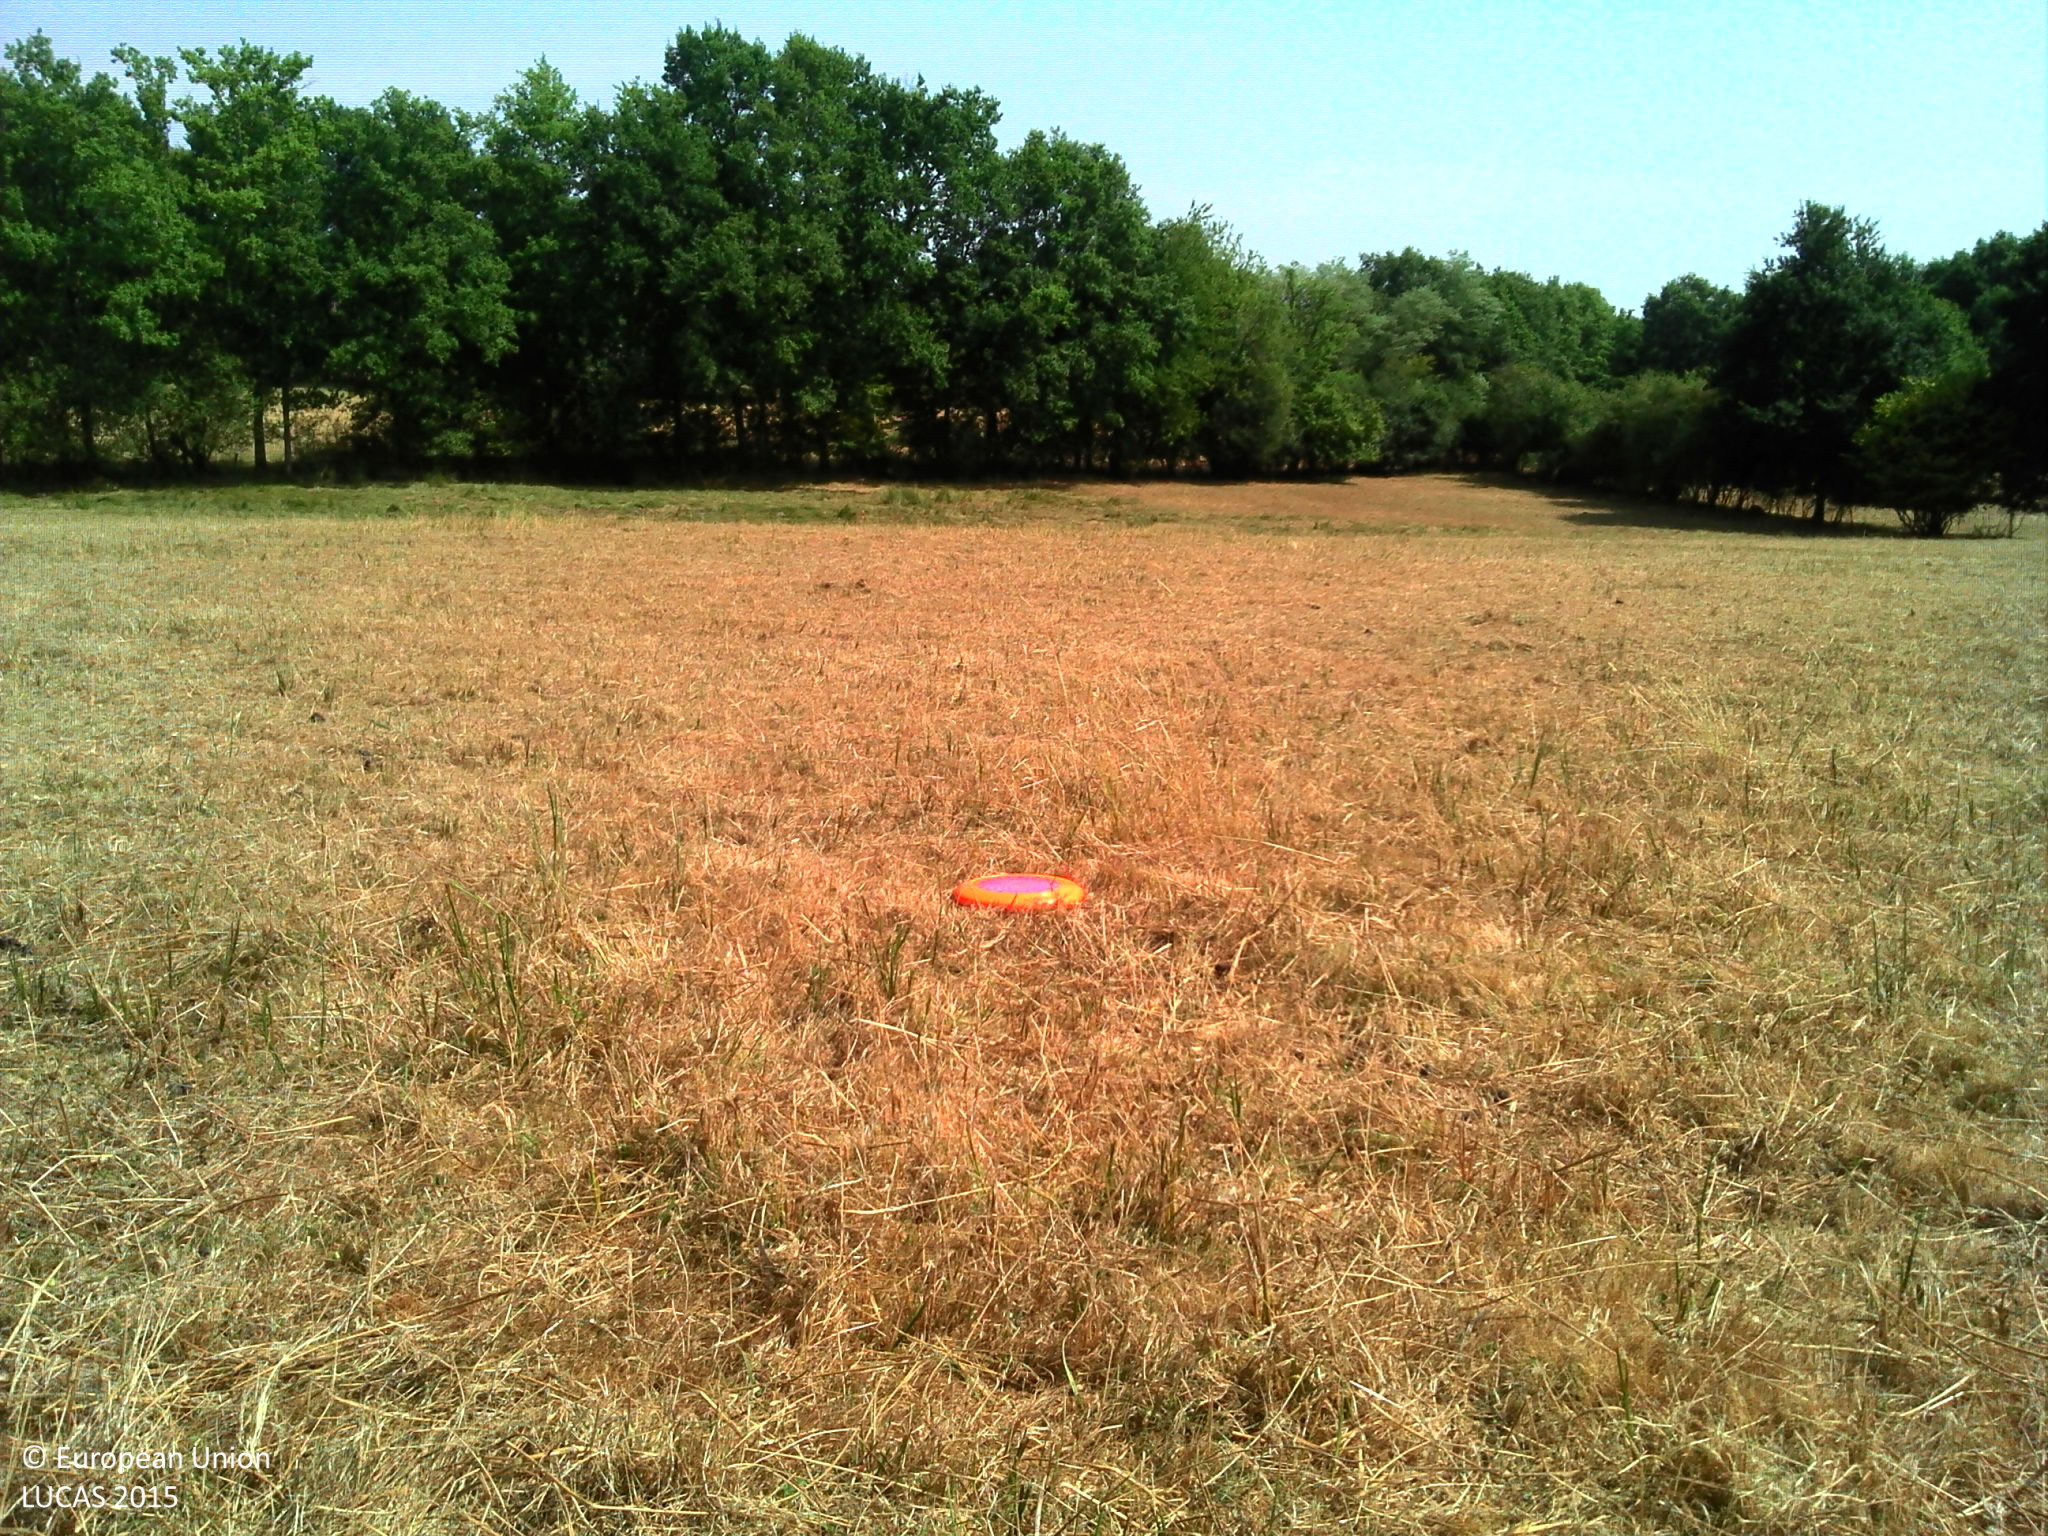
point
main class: Grassland
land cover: Grassland without tree/shrub cover
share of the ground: > 75 %
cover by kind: herbaceous plants 95 %
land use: Agriculture (excluding fallow land and kitchen gardens)
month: July
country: FR
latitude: 45.7719
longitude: 1.0004
